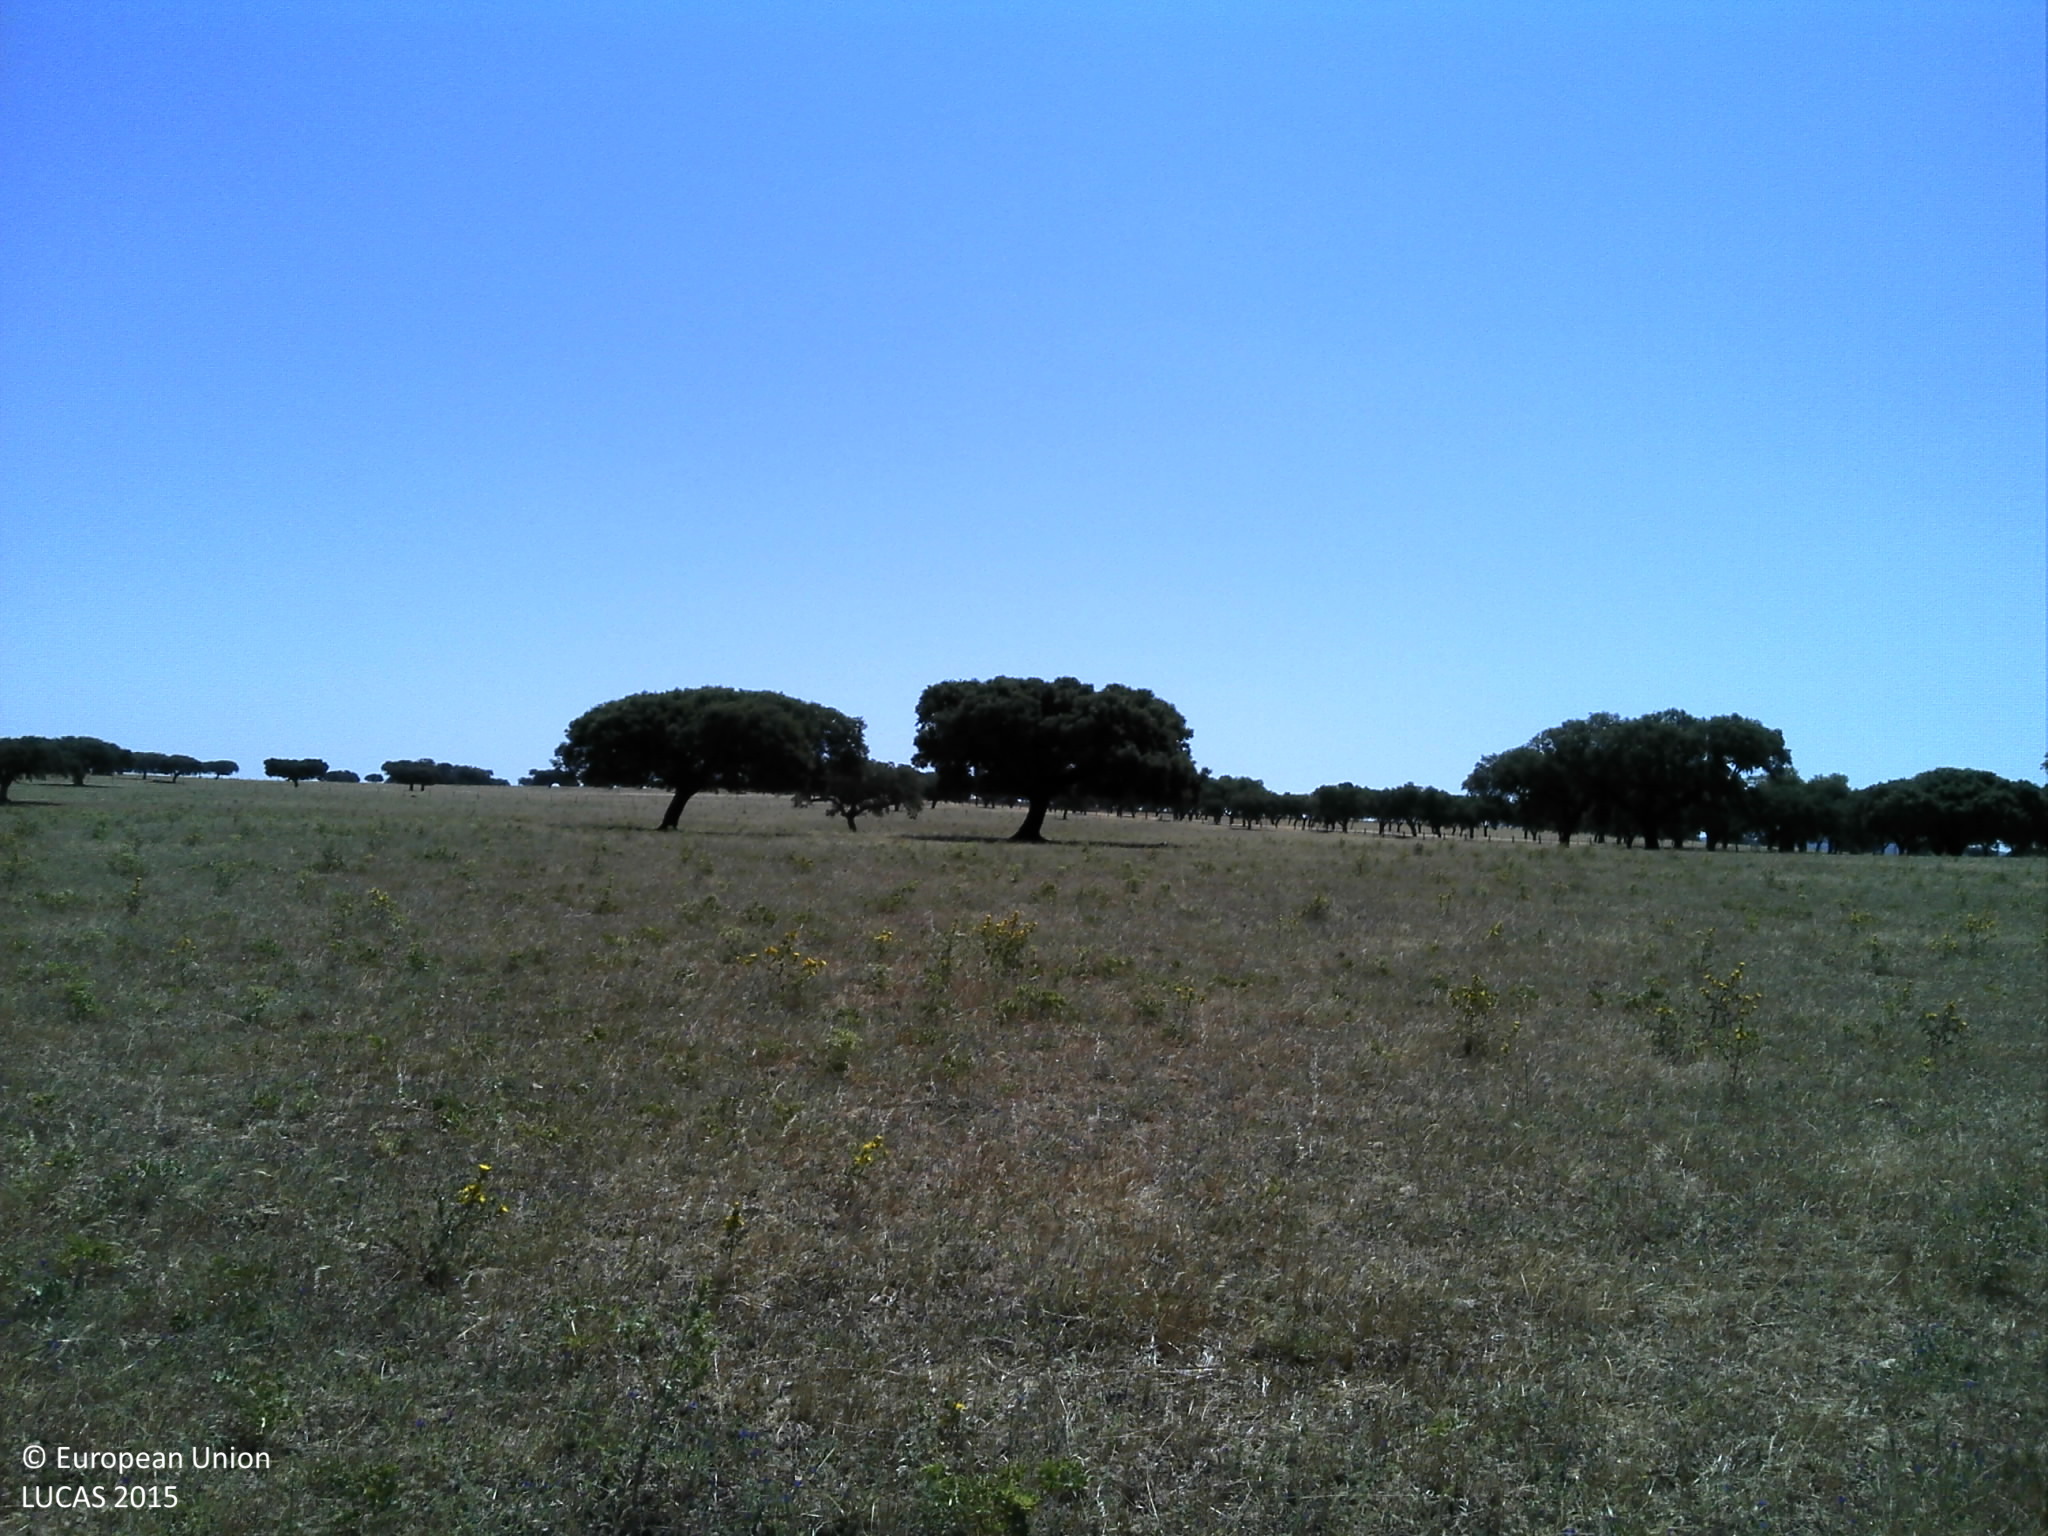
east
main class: Grassland
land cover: Grassland without tree/shrub cover
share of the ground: > 75 %
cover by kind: herbaceous plants 90 %, unconsolidated bare surface 10 %
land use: Agriculture (excluding fallow land and kitchen gardens)
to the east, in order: Grassland without tree/shrub cover; Broadleaved woodland; Grassland without tree/shrub cover; Single bushes/trees; Grassland without tree/shrub cover
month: June
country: PT
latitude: 38.8034
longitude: -7.8326
